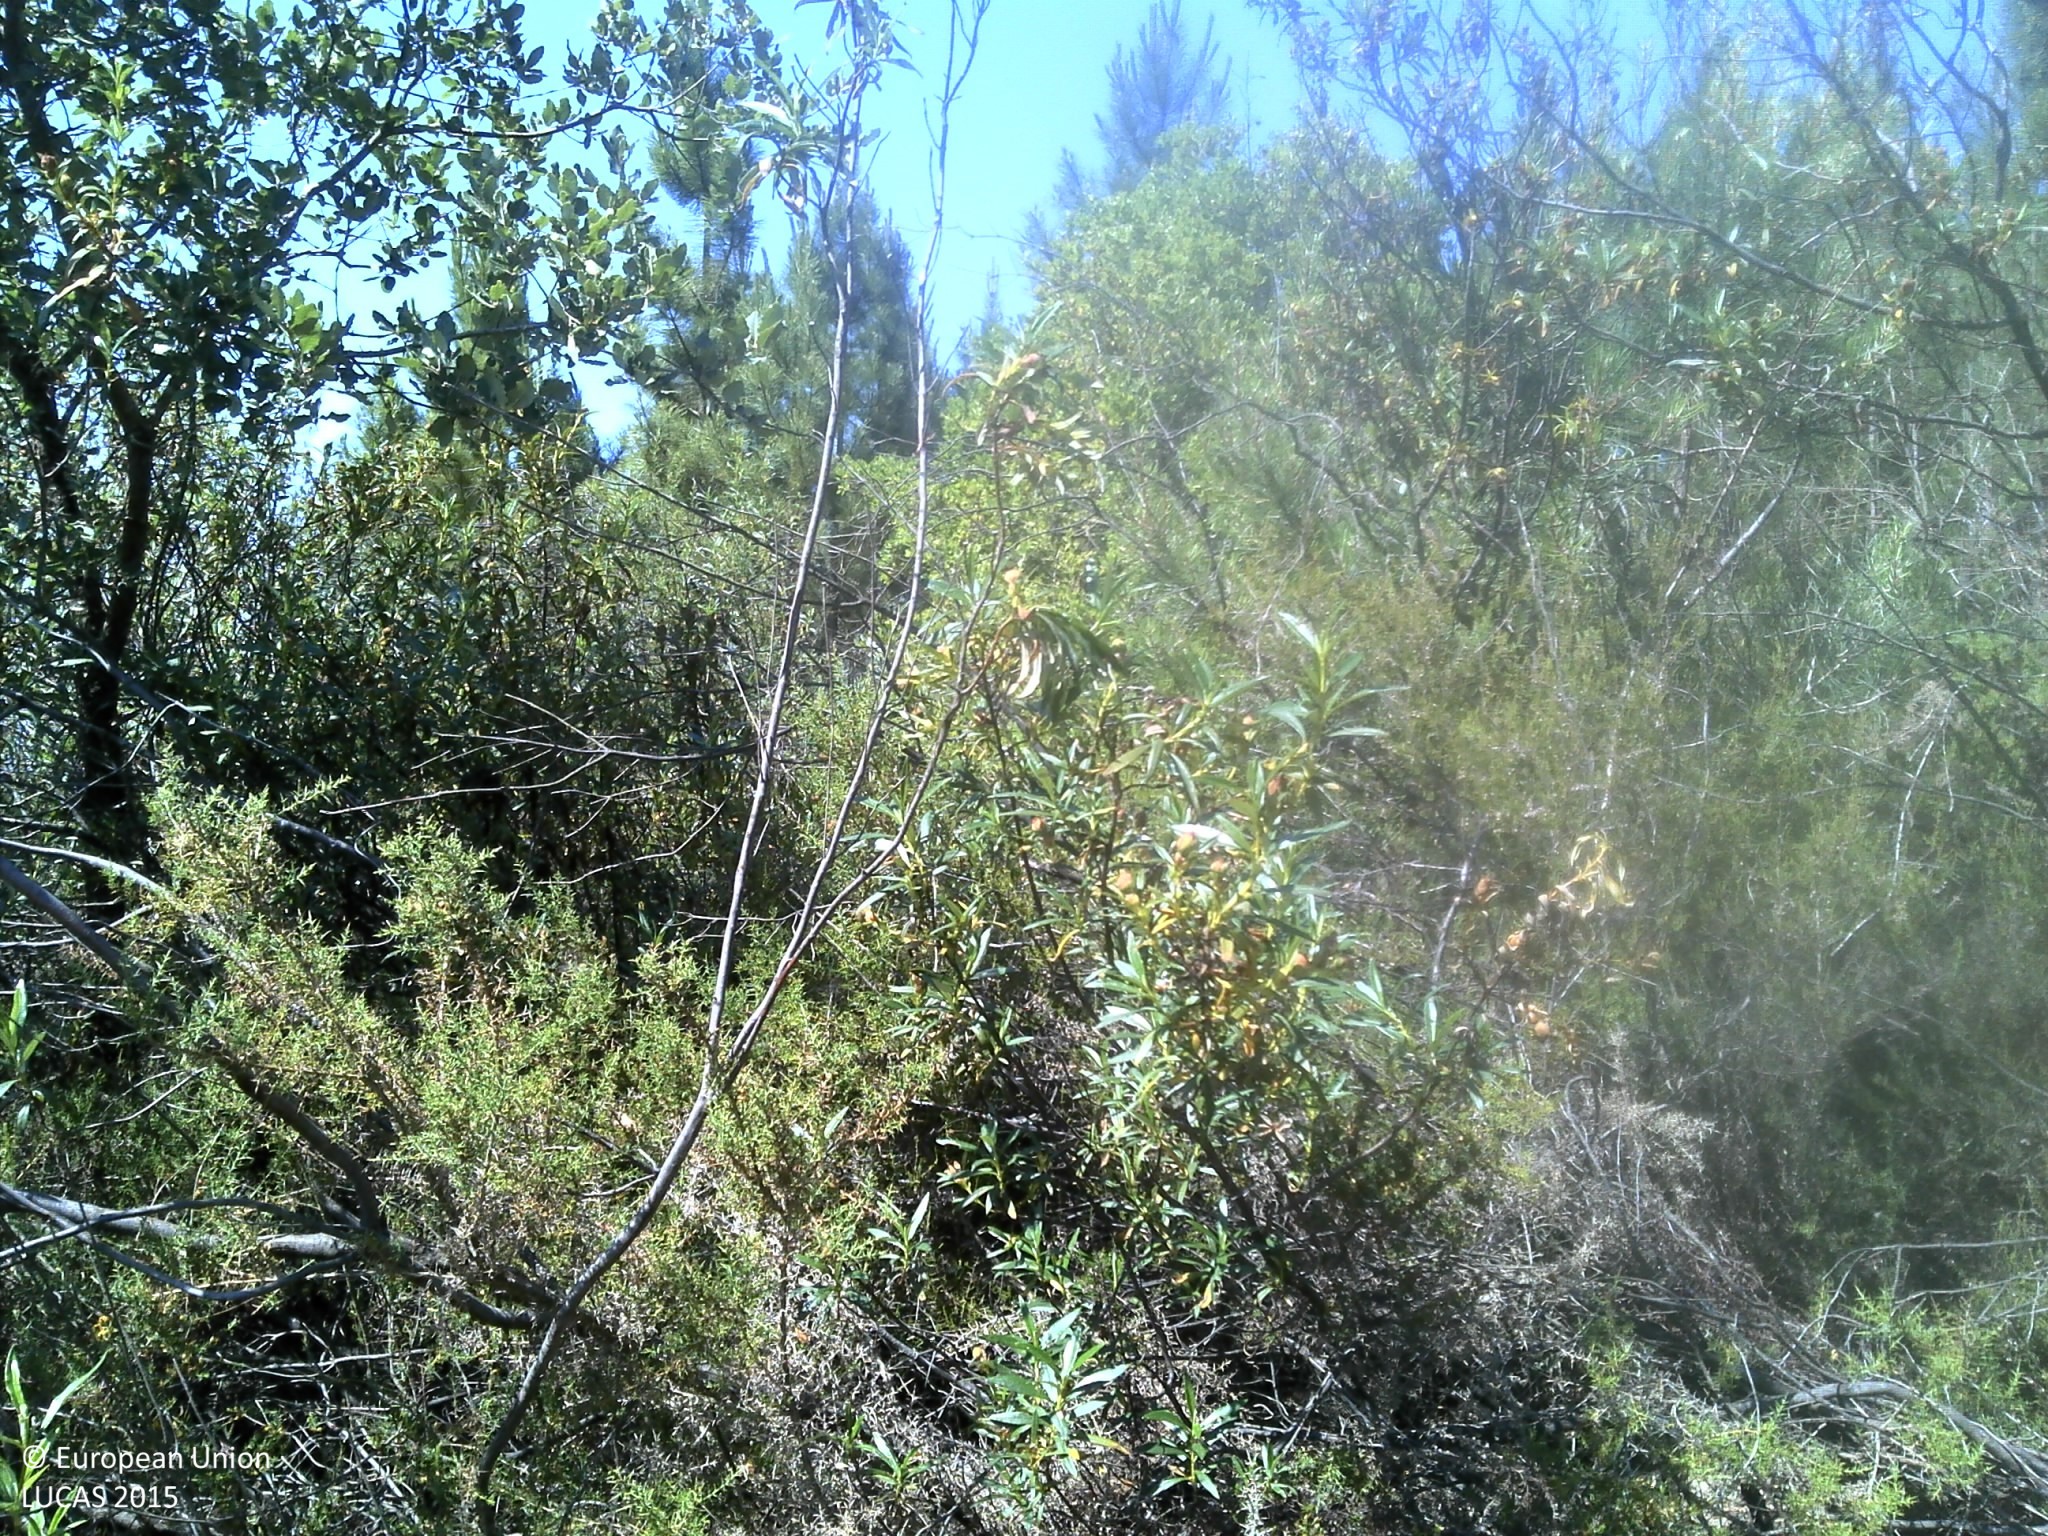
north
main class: Shrubland
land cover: Shrubland with sparse tree cover
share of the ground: 50 - 75 %
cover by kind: shrubs 75 %, unconsolidated bare surface 15 %, broadleaved forest trees 5 %, herbaceous plants 5 %
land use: Abandoned areas
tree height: > 5 m
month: May
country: PT
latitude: 39.5113
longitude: -8.3882
